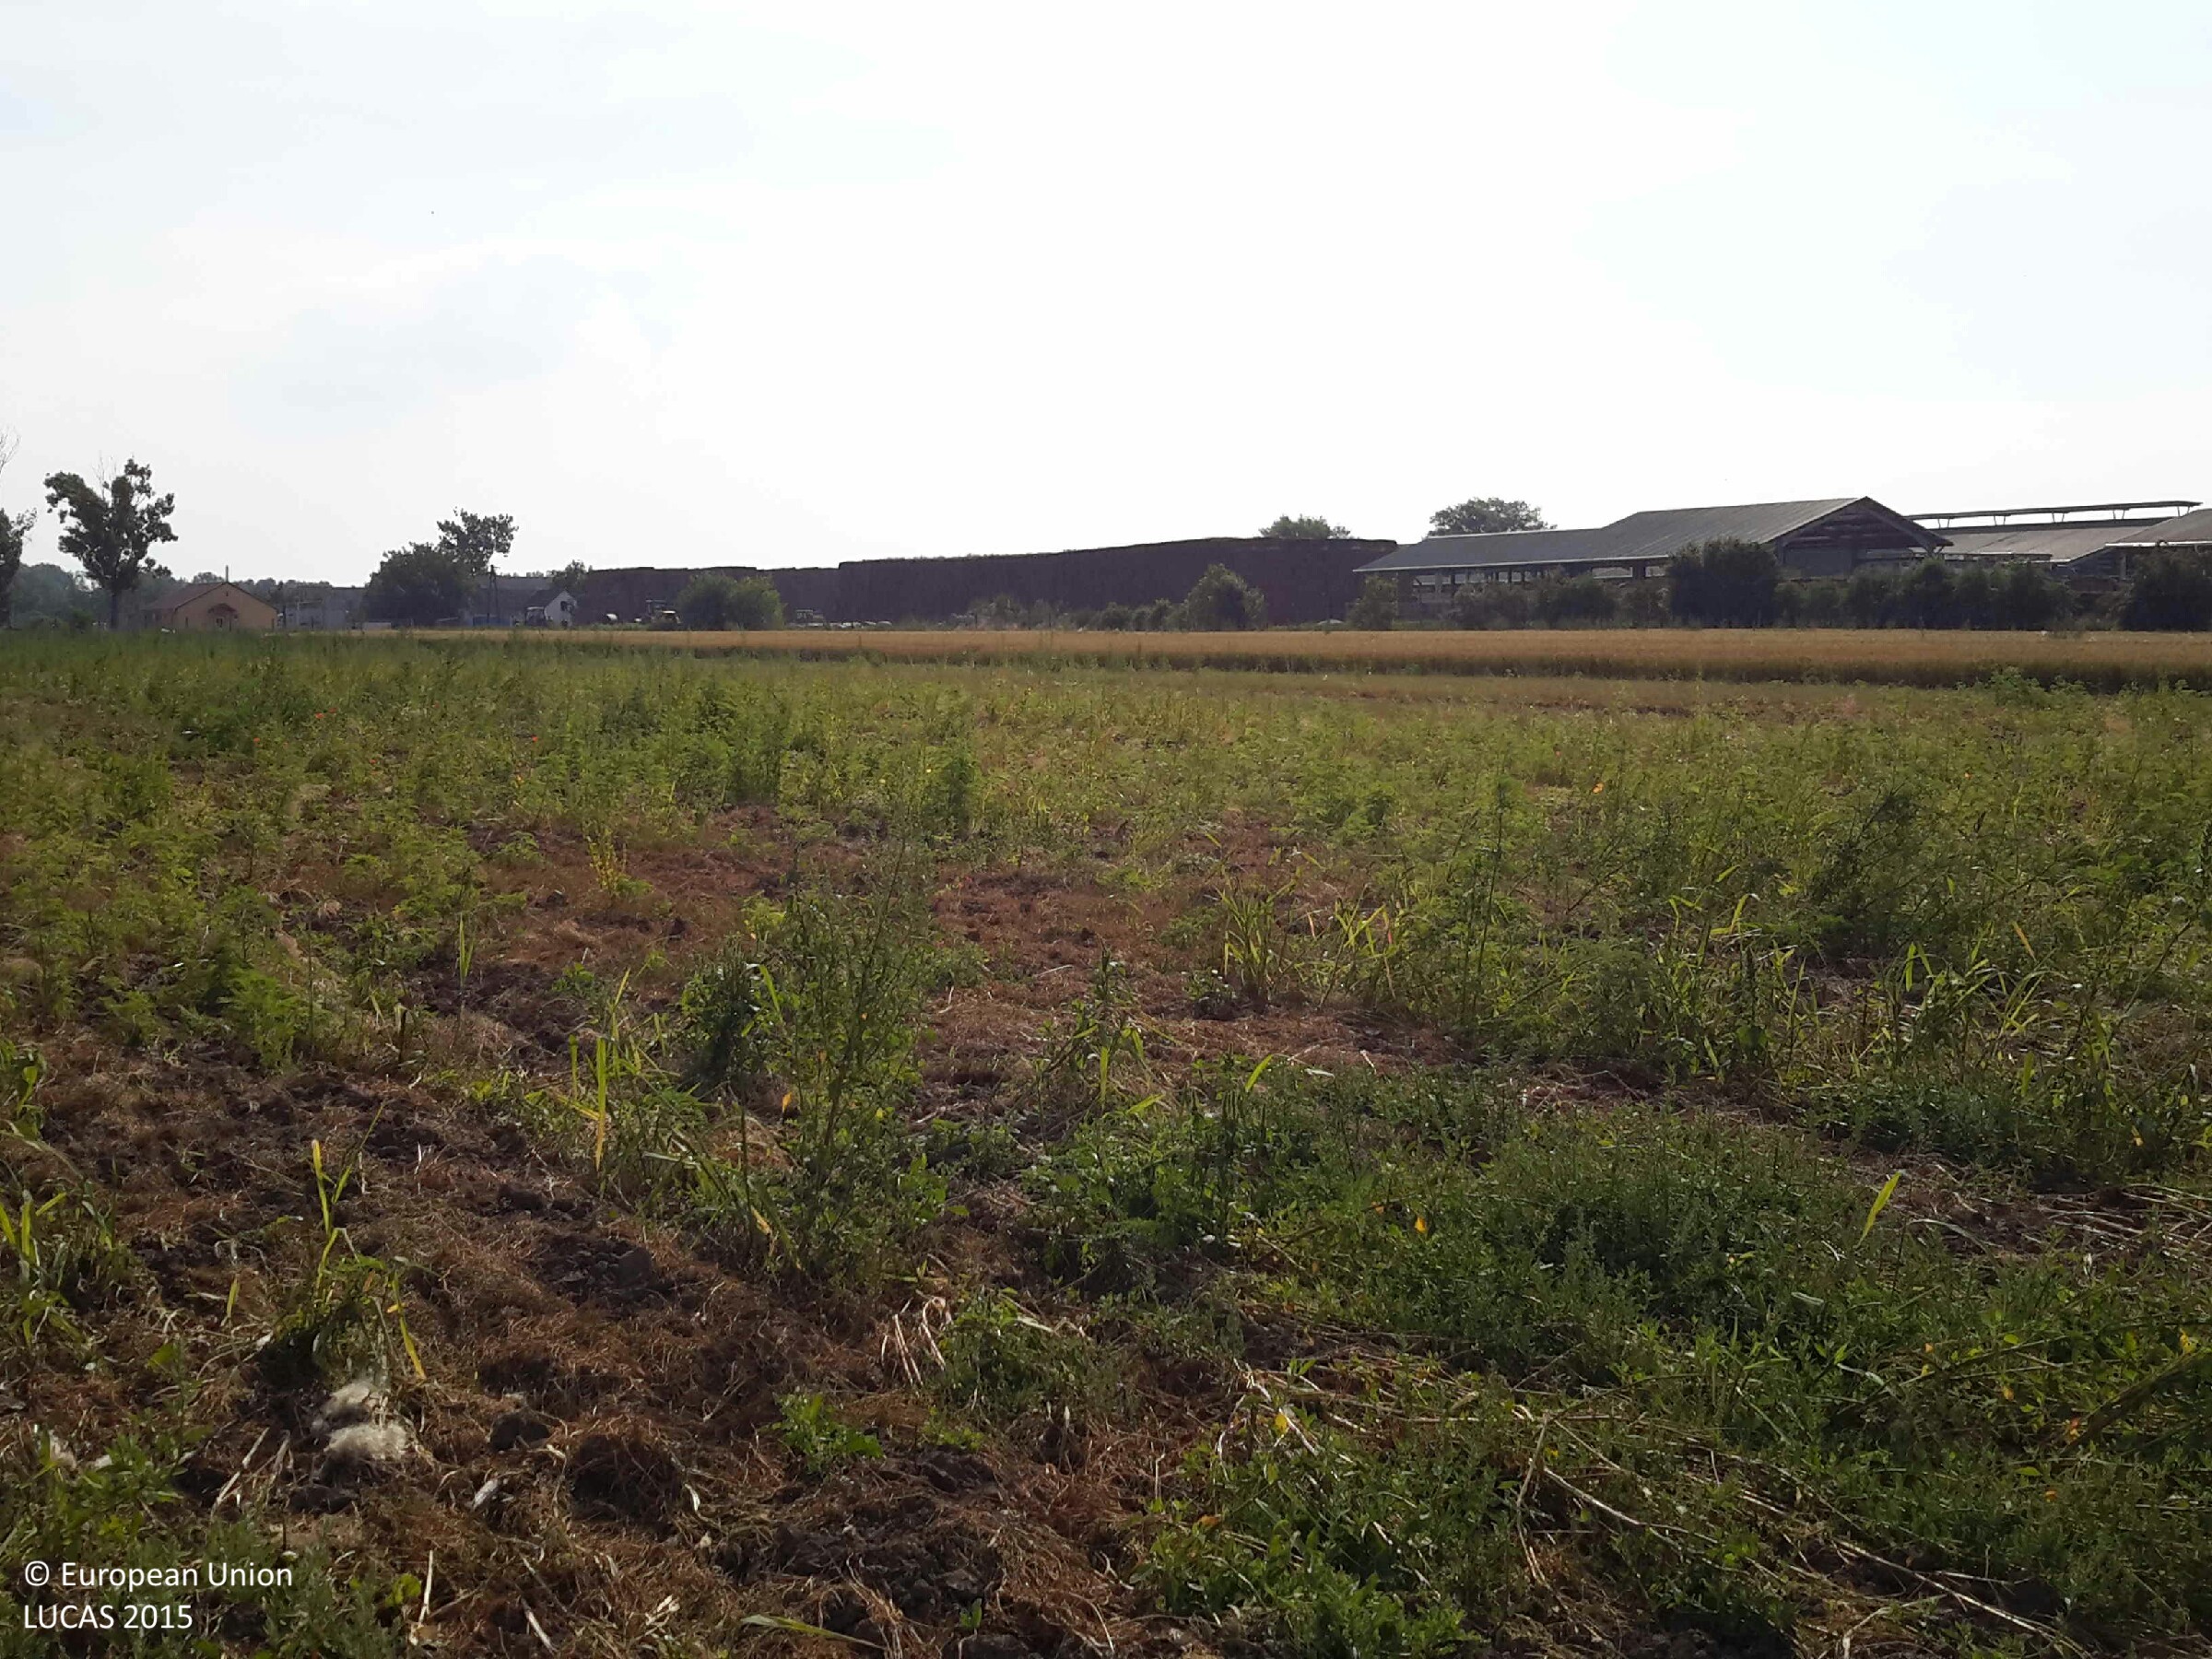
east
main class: Grassland
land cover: Spontaneously vegetated surfaces
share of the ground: 50 - 75 %
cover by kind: herbaceous plants 60 %, unconsolidated bare surface 40 %
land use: Fallow land
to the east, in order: Spontaneously vegetated surfaces; Durum wheat; Common wheat; Grass margins; Artificial constructions in urban areas
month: July
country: HU
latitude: 47.3918
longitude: 17.4662
